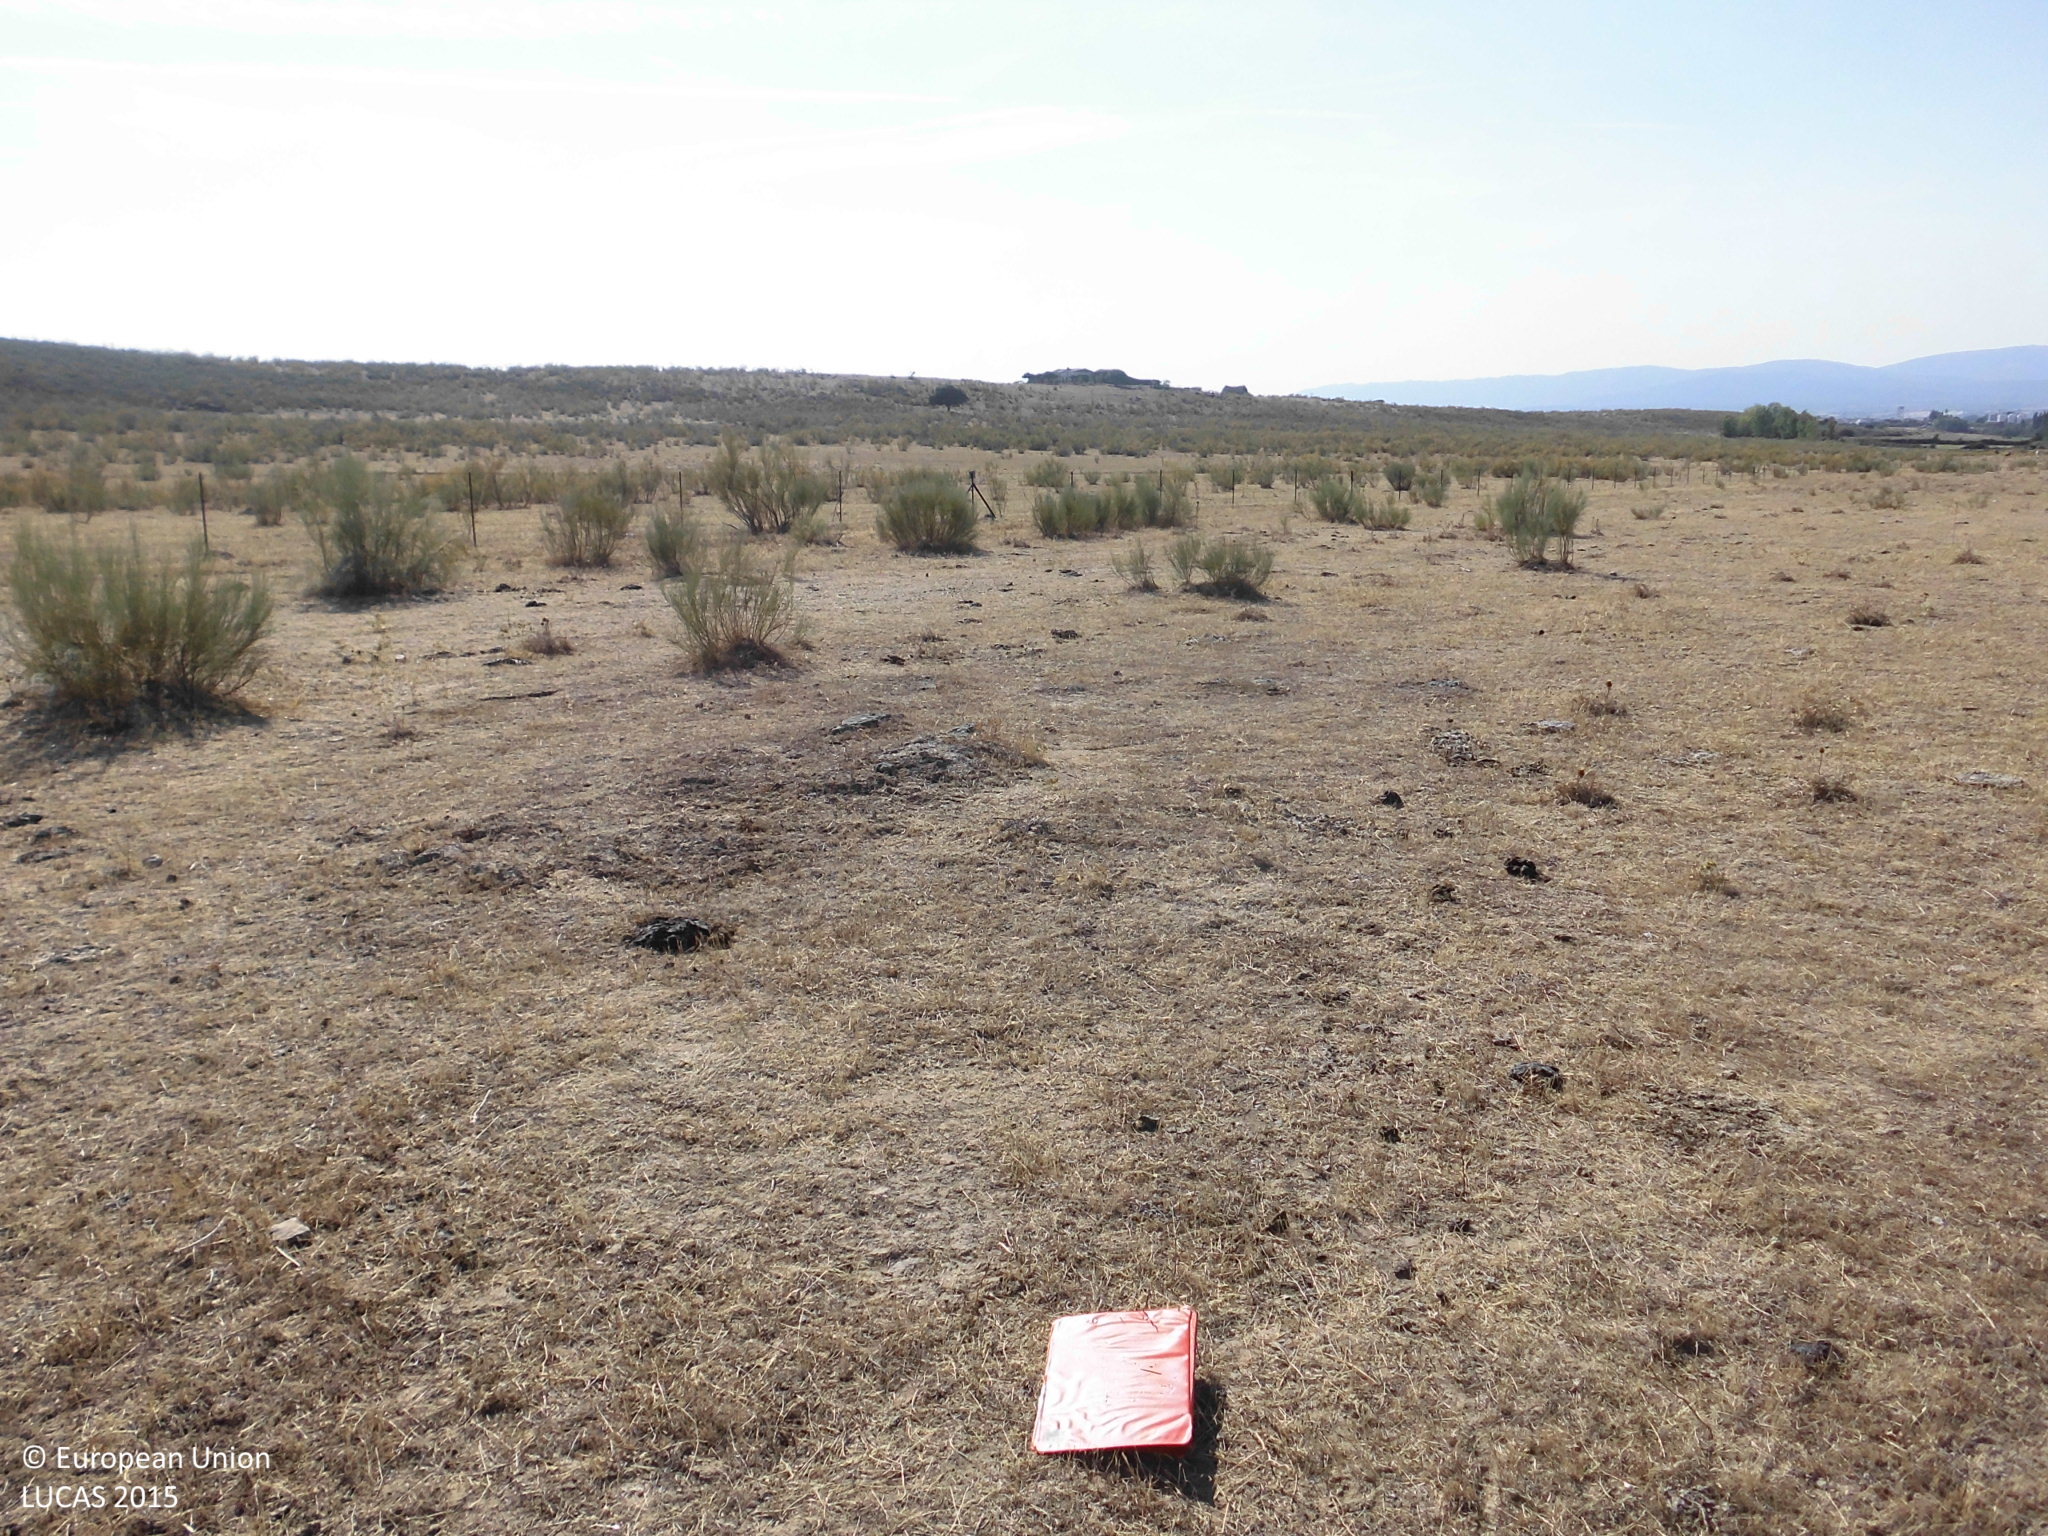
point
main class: Grassland
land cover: Grassland without tree/shrub cover
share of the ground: > 75 %
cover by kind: herbaceous plants 100 %
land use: Agriculture (excluding fallow land and kitchen gardens)
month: July
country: ES
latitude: 40.0403
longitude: -6.5959
